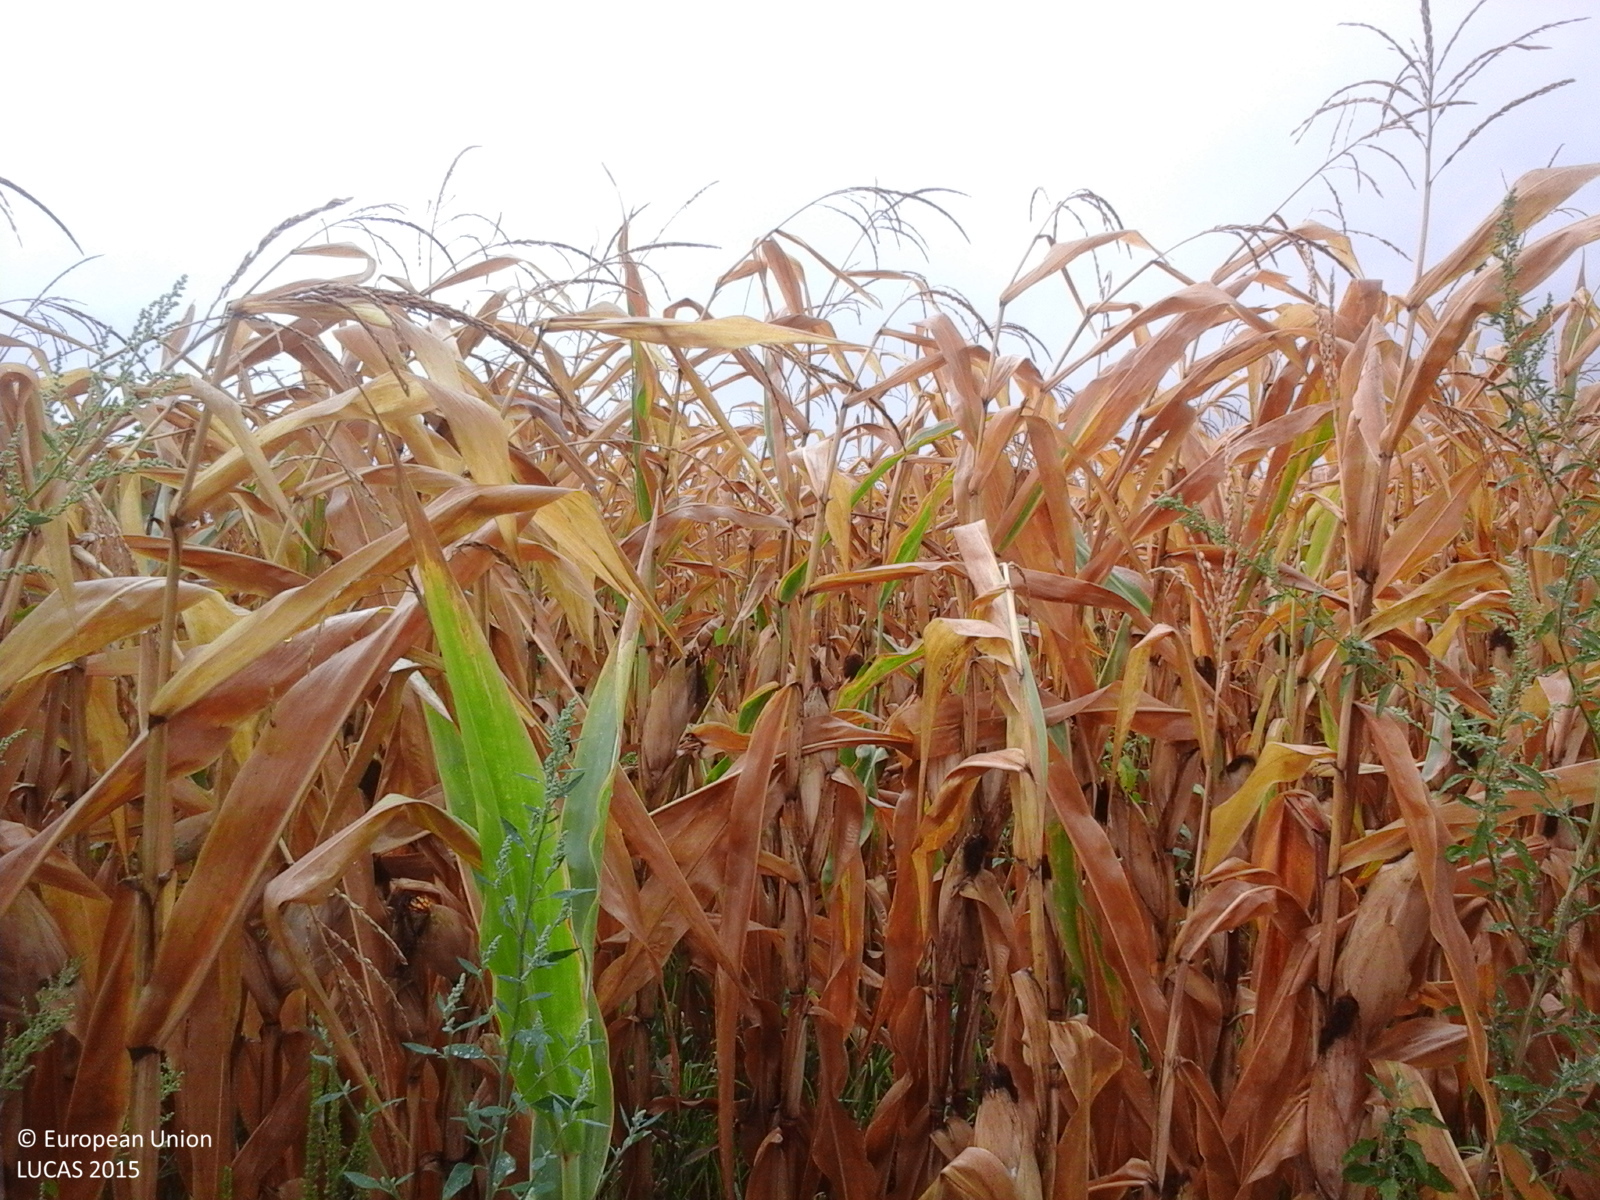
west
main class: Cropland
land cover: Maize
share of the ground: > 75 %
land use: Agriculture (excluding fallow land and kitchen gardens)
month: August
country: RO
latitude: 45.9026
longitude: 20.7114
